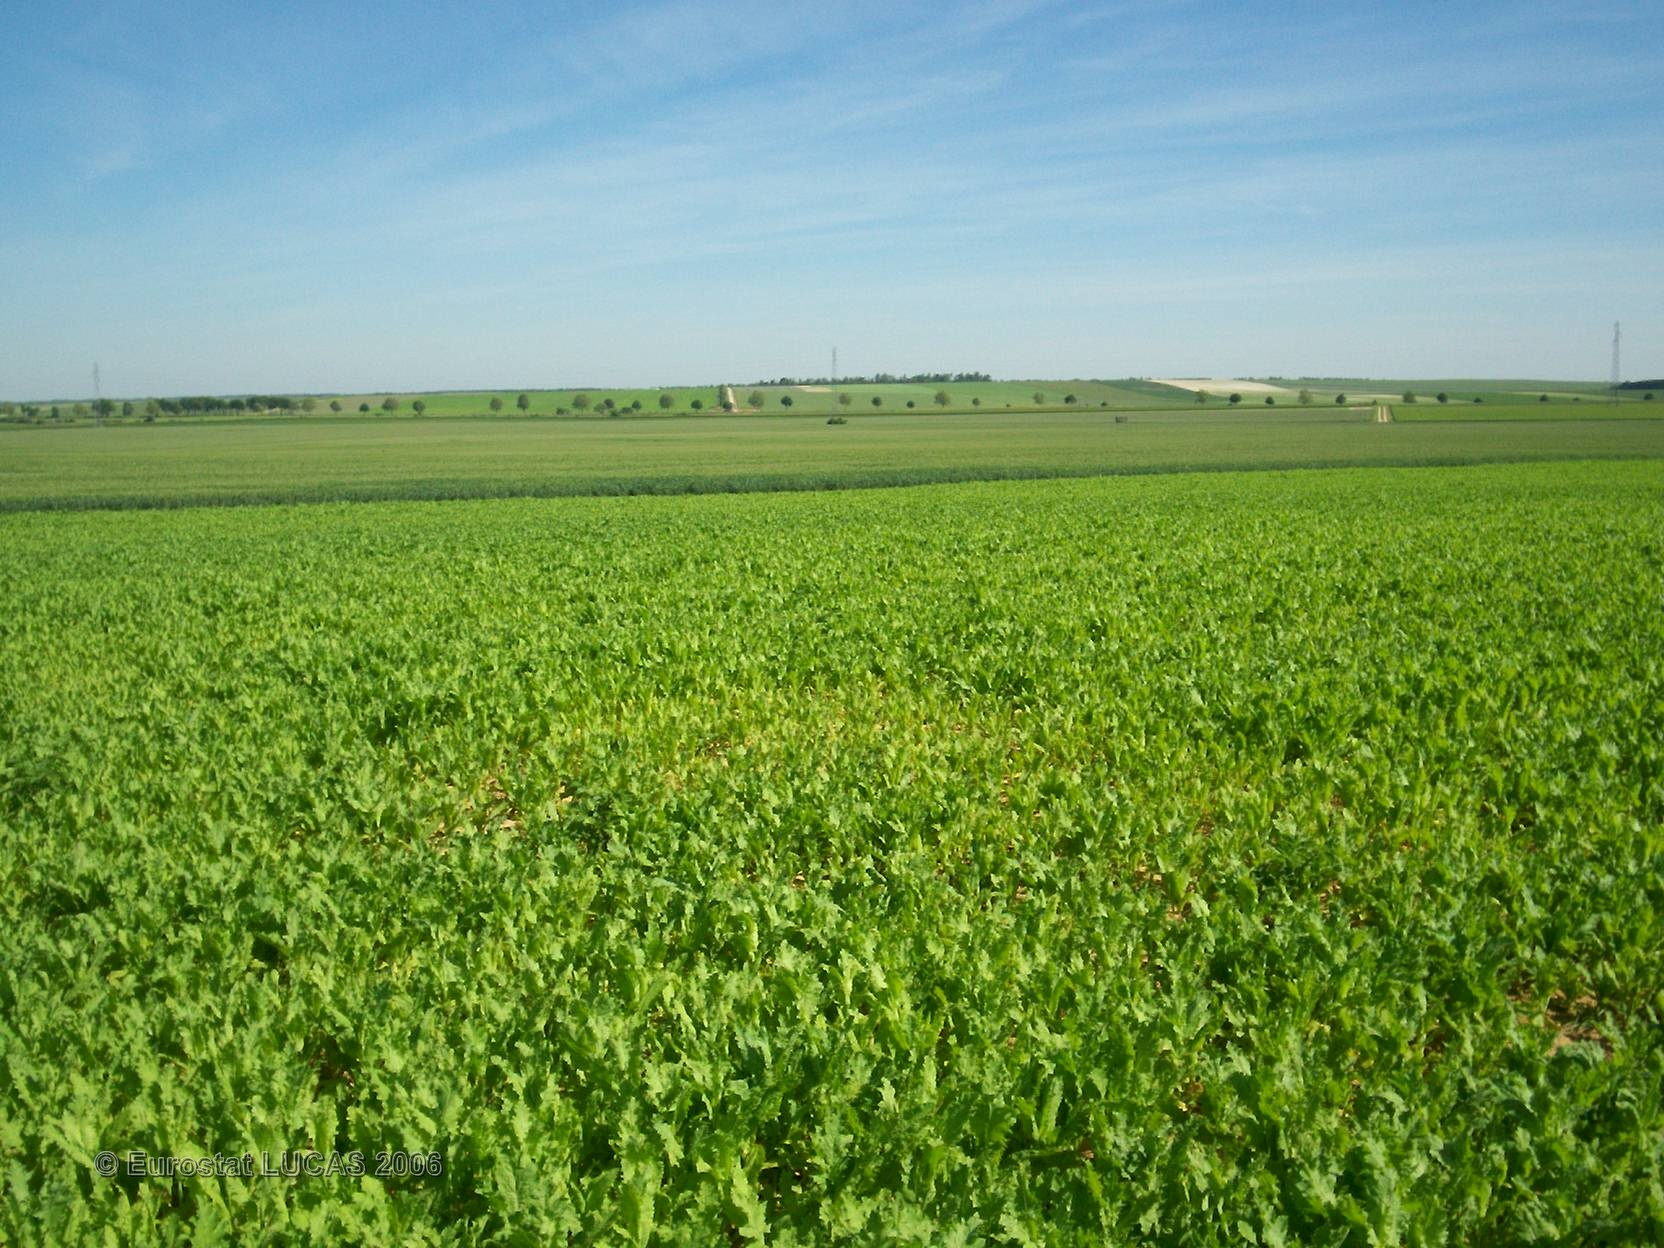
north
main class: Cropland
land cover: Other fibre and oleaginous crops
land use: Agriculture (excluding fallow land and kitchen gardens)
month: June
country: FR
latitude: 49.1017
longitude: 4.6140
